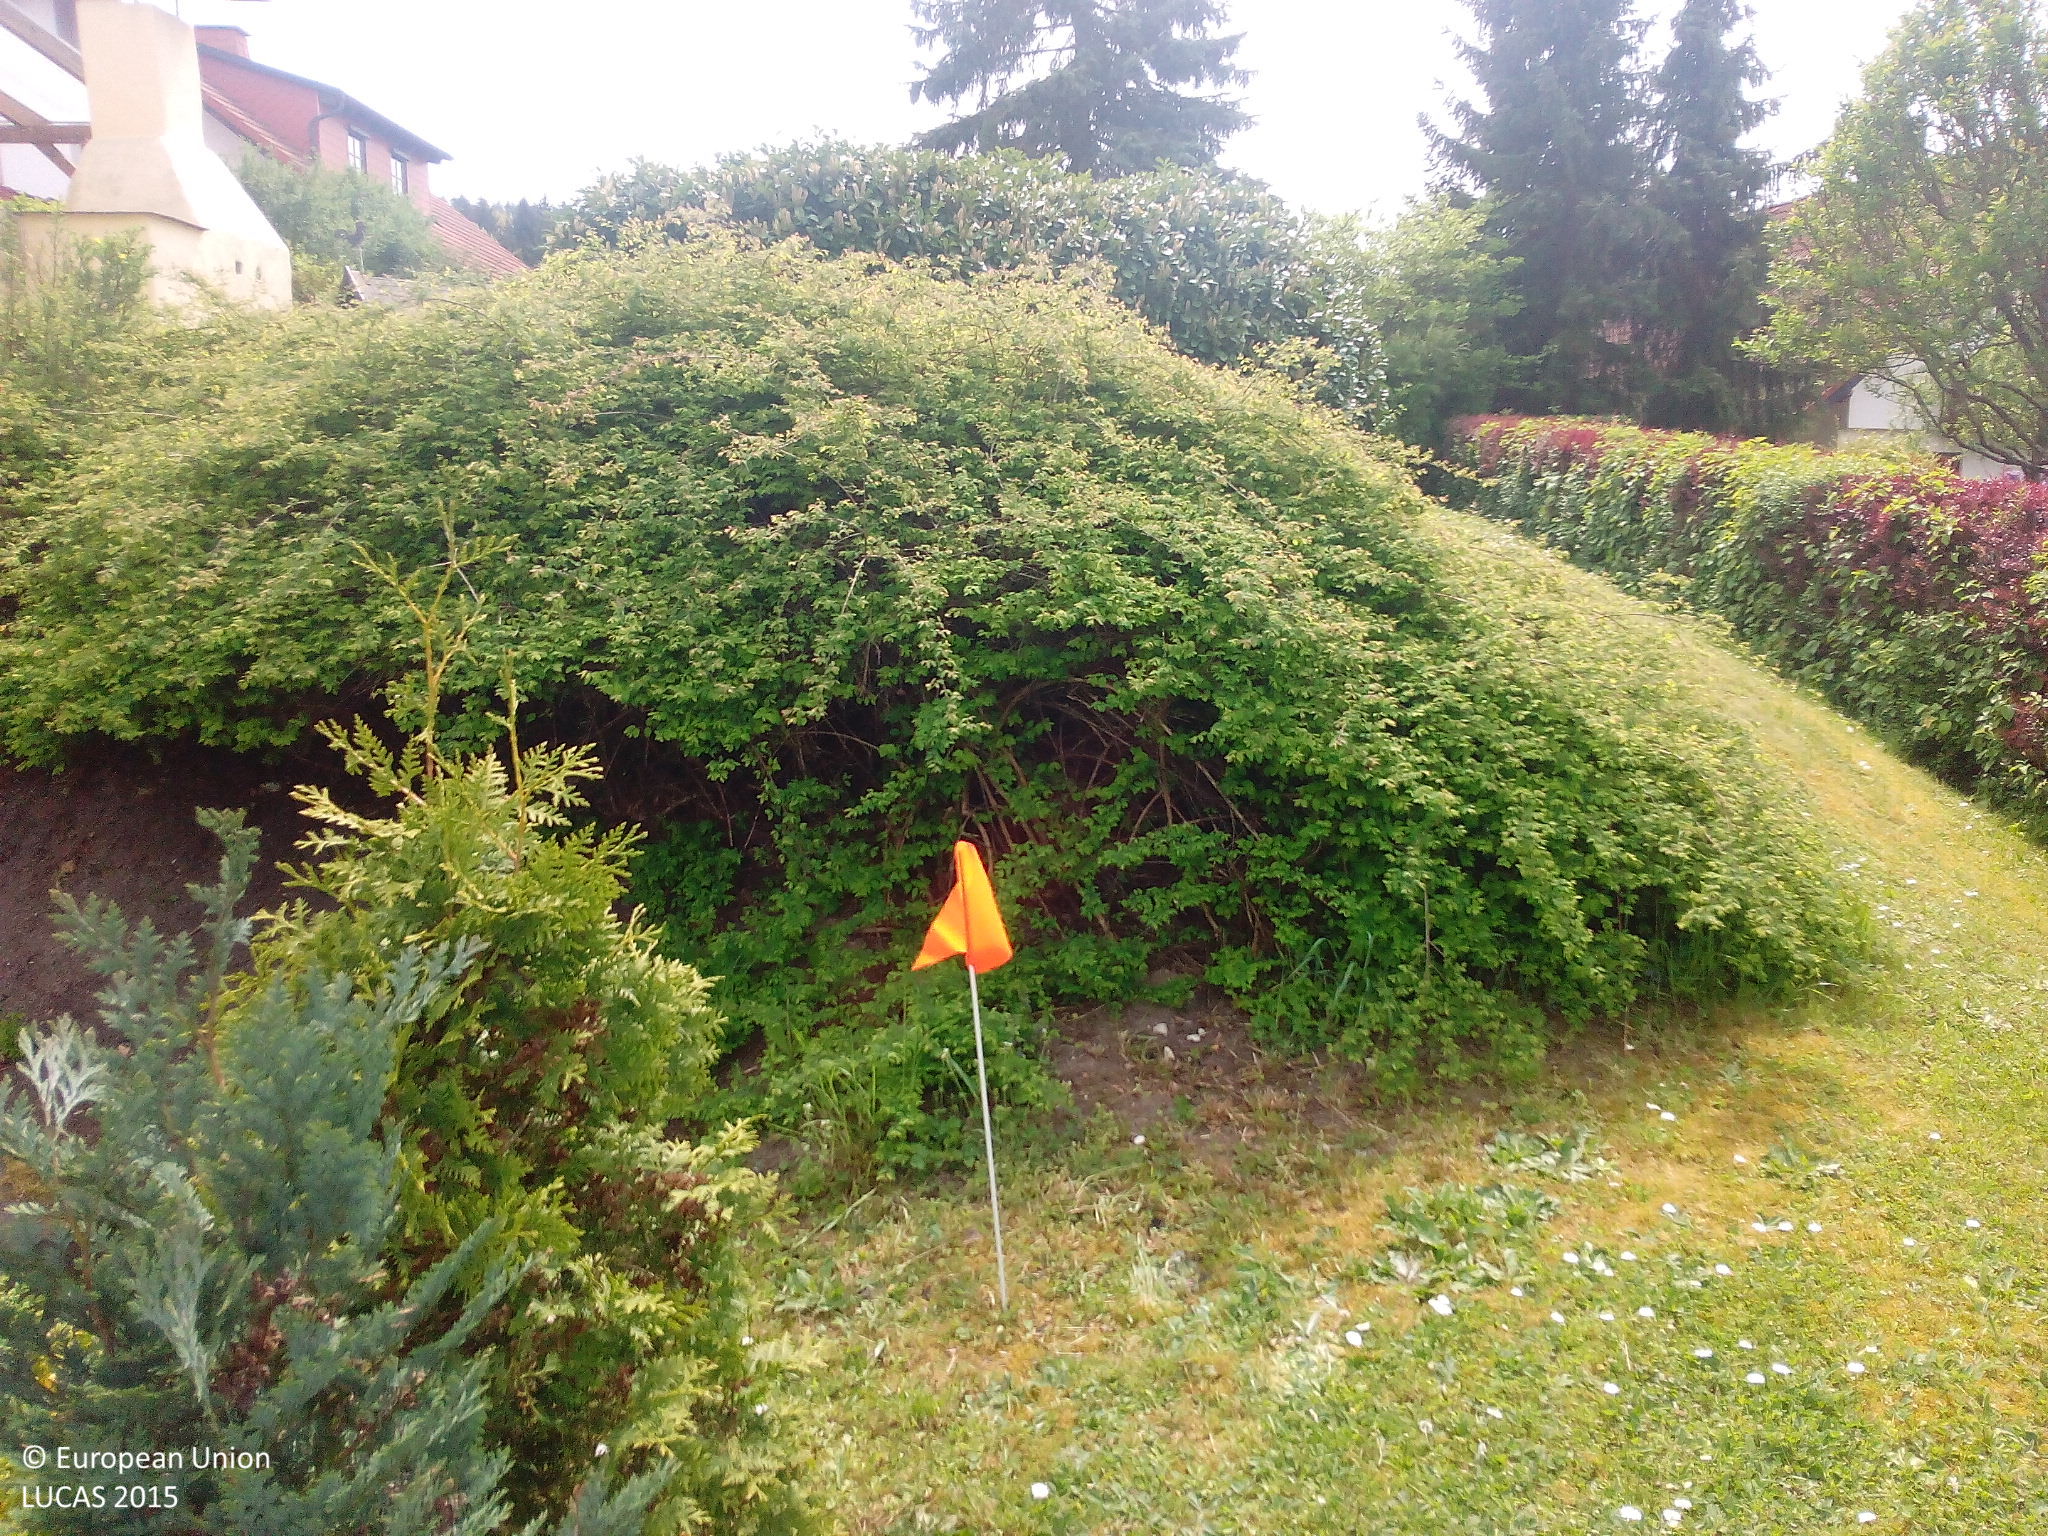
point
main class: Grassland
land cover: Grassland without tree/shrub cover
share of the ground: > 75 %
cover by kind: herbaceous plants 100 %
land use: Residential
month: May
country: DE
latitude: 50.2873
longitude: 11.0523
